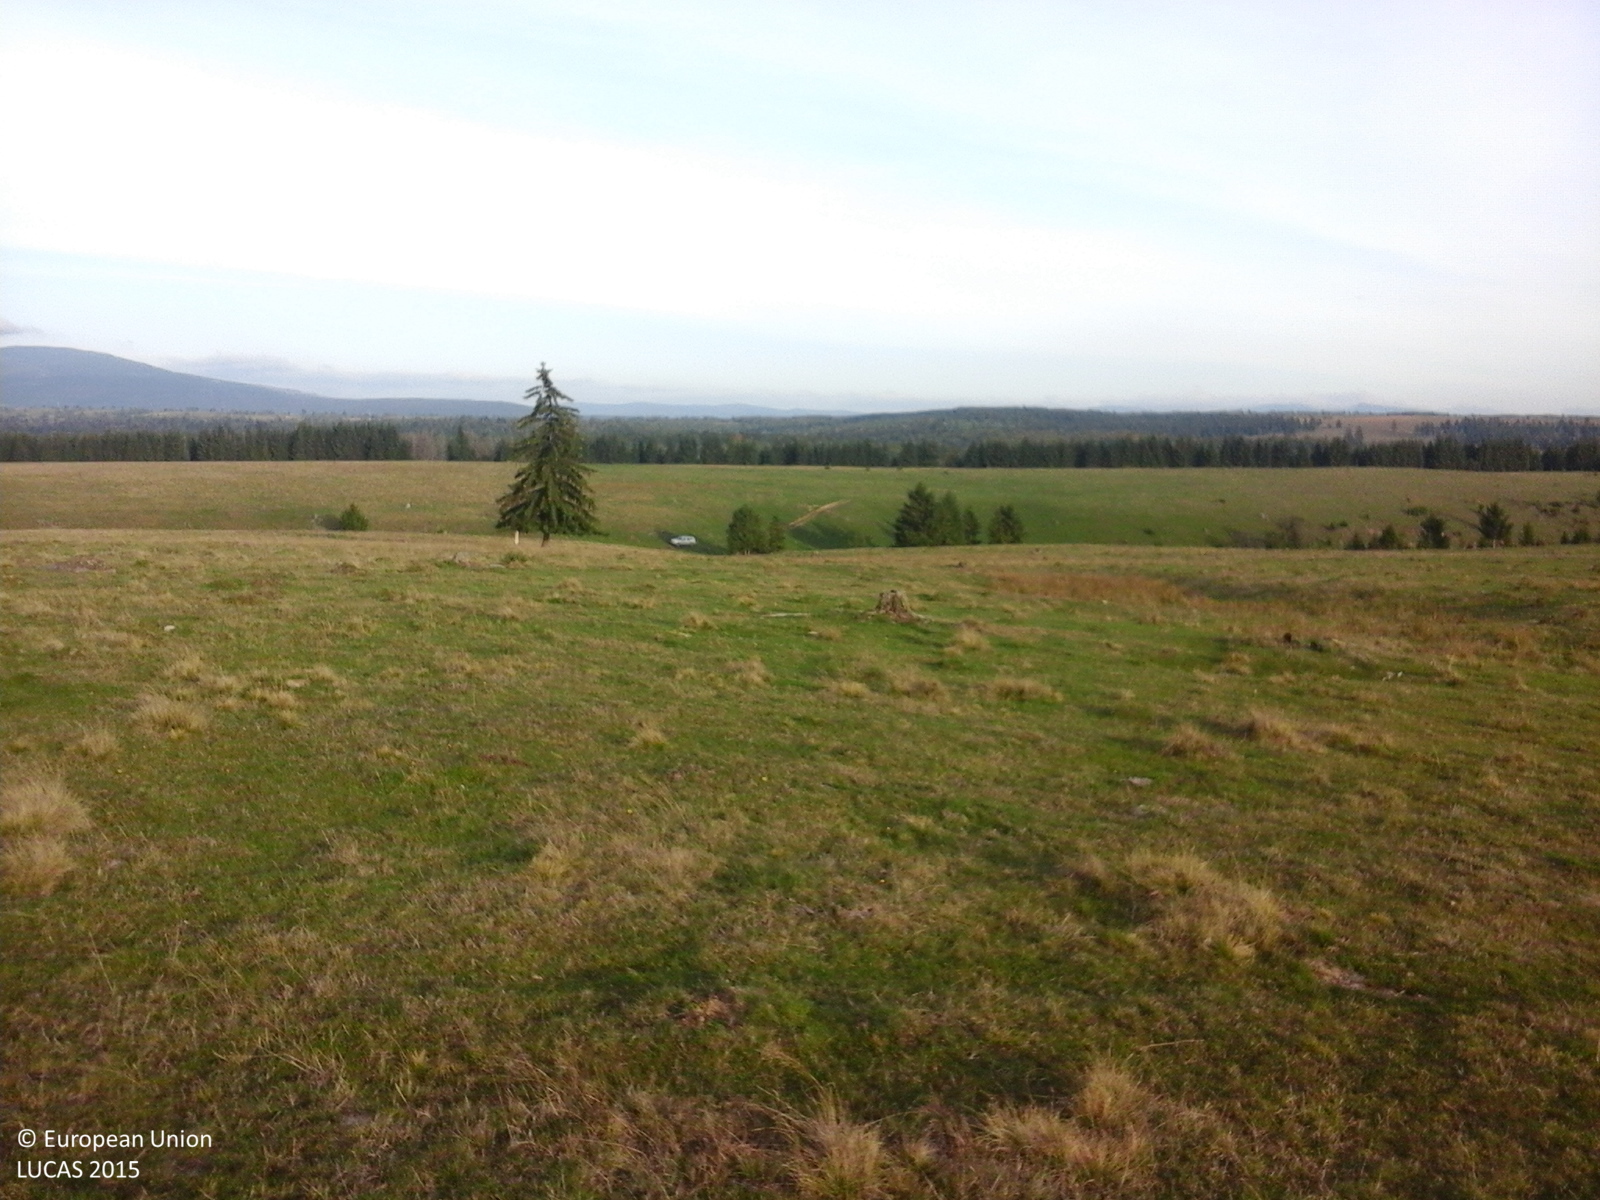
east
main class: Grassland
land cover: Grassland without tree/shrub cover
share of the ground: > 75 %
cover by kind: herbaceous plants 100 %
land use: Agriculture (excluding fallow land and kitchen gardens)
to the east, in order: Grassland without tree/shrub cover; Single bushes/trees; Grassland without tree/shrub cover; Single bushes/trees; Grassland without tree/shrub cover
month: October
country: RO
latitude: 46.3380
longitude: 25.4497
